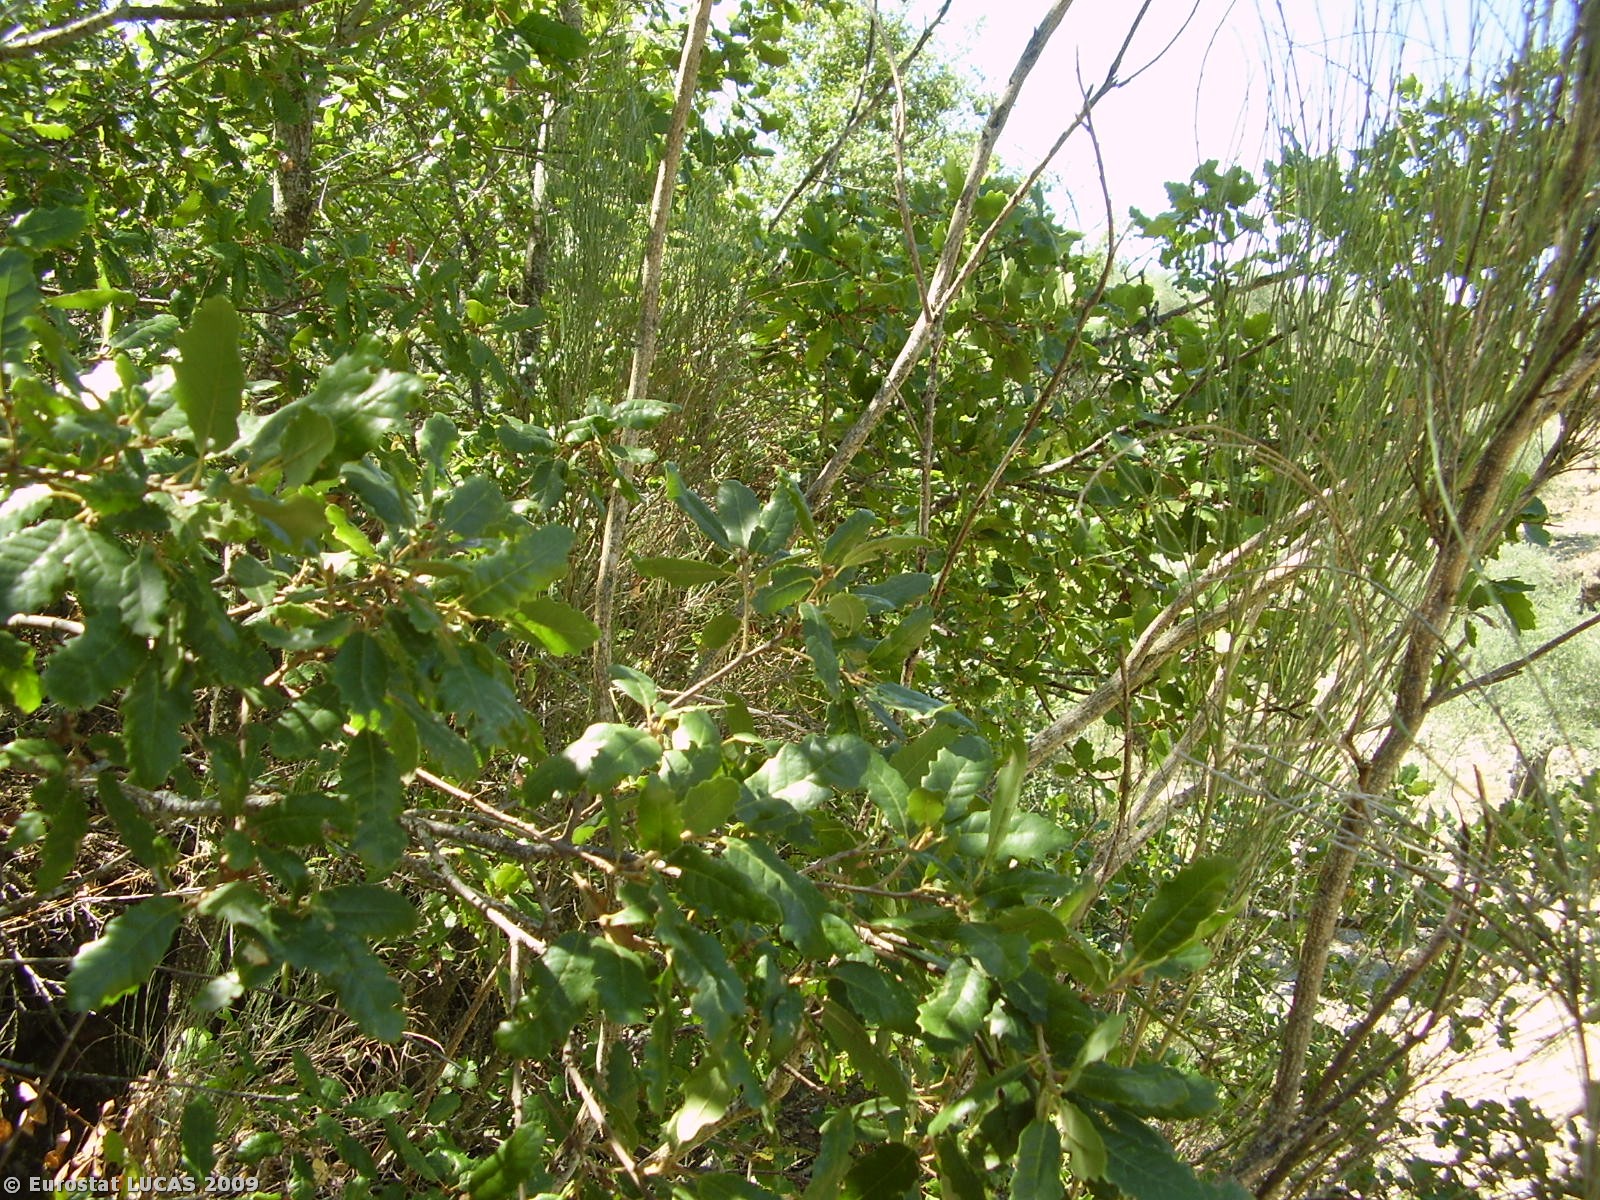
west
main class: Cropland
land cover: Olive groves
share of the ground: 50 - 75 %
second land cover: Bare land
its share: > 75 %
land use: Agriculture (excluding fallow land and kitchen gardens)
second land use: Fallow land
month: August
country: PT
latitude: 41.1985
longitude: -6.7137
